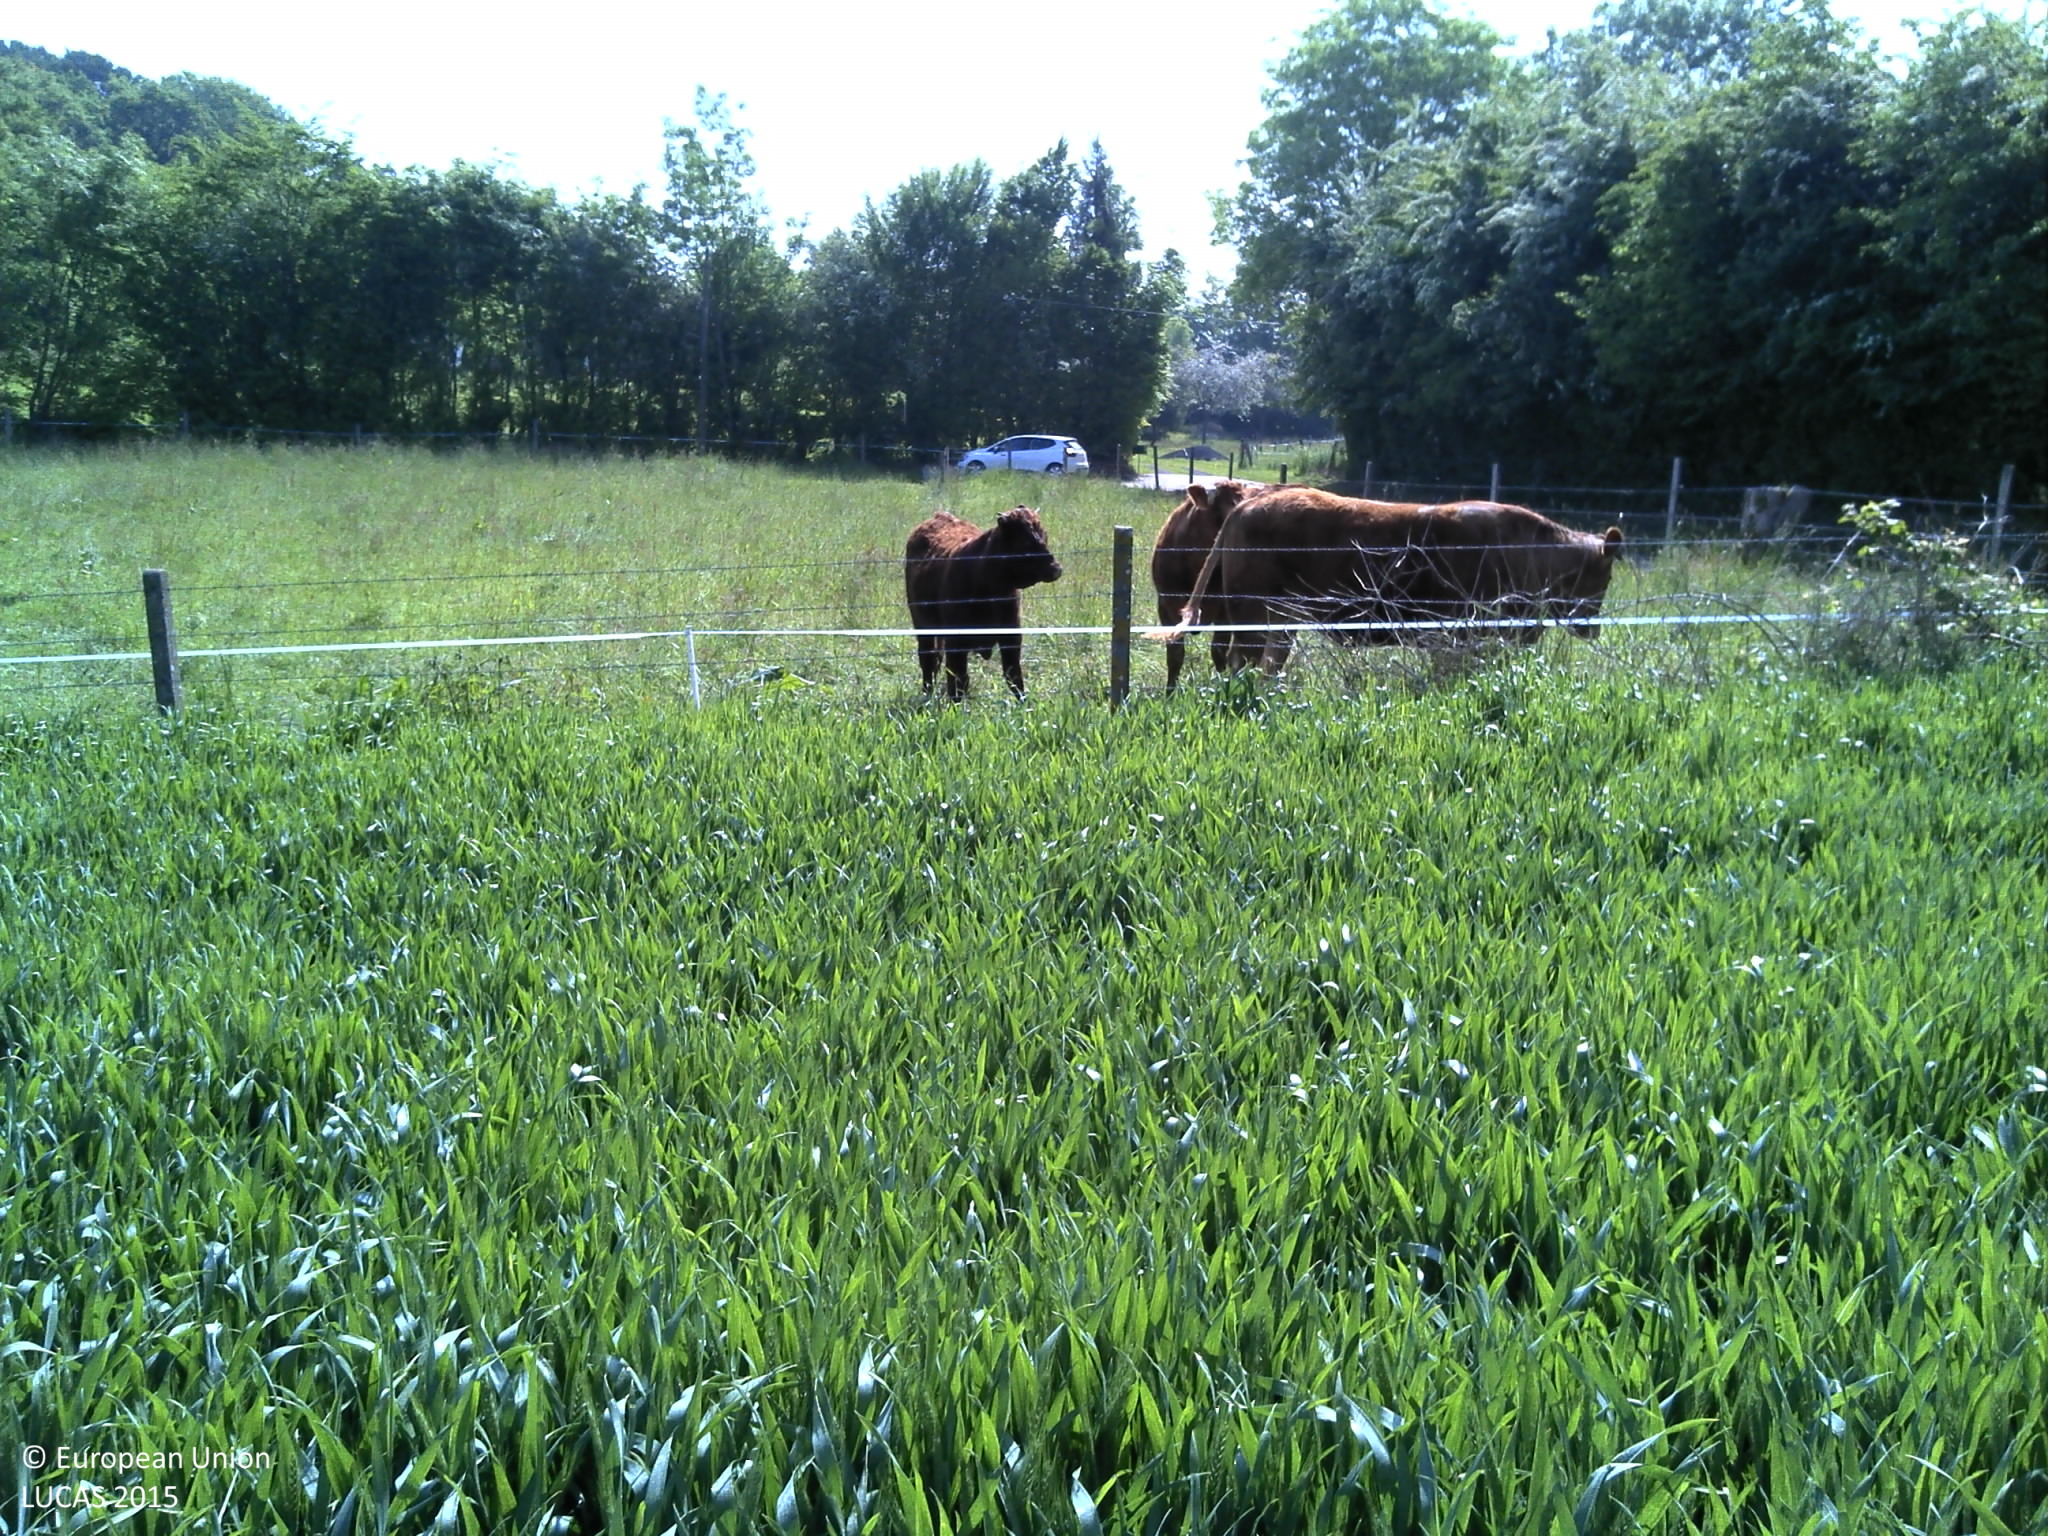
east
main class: Cropland
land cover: Durum wheat
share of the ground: > 75 %
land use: Agriculture (excluding fallow land and kitchen gardens)
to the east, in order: Durum wheat; Fences; Grassland without tree/shrub cover; Fences; Electric lines; Paved roads, cycling and walking lanes; Lines of trees; Grassland without tree/shrub cover; Grassland with sparse tree/shrub cover; Grassland without tree/shrub cover; Broadleaved woodland; Grassland without tree/shrub cover
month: May
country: FR
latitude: 49.6437
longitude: 0.9617
